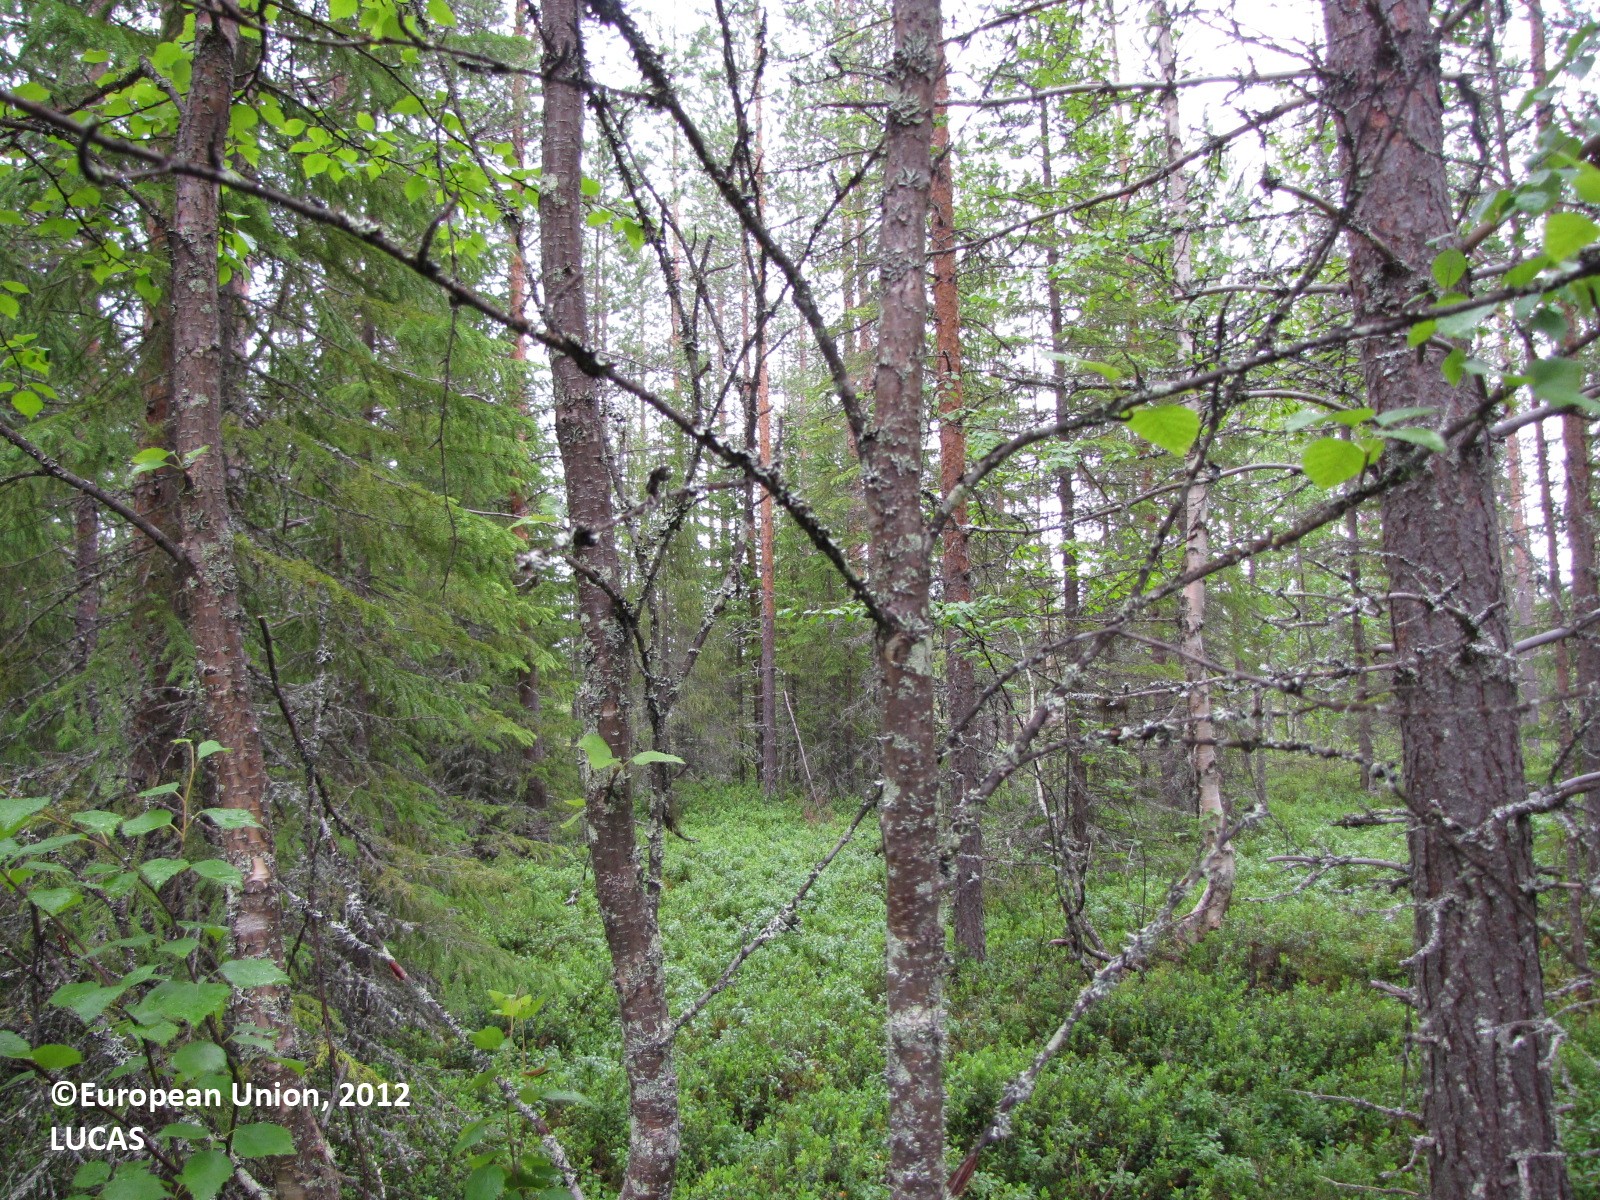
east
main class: Woodland
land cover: Other coniferous woodland
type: boreal forest
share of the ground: 50 - 75 %
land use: Forestry
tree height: > 5 m
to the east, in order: Other coniferous woodland; Pine dominated mixed woodland; Ditches and canals; Paved roads, cycling and walking lanes; Ditches and canals; Pine dominated coniferous woodland
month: July
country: FI
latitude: 66.6281
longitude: 24.8916
